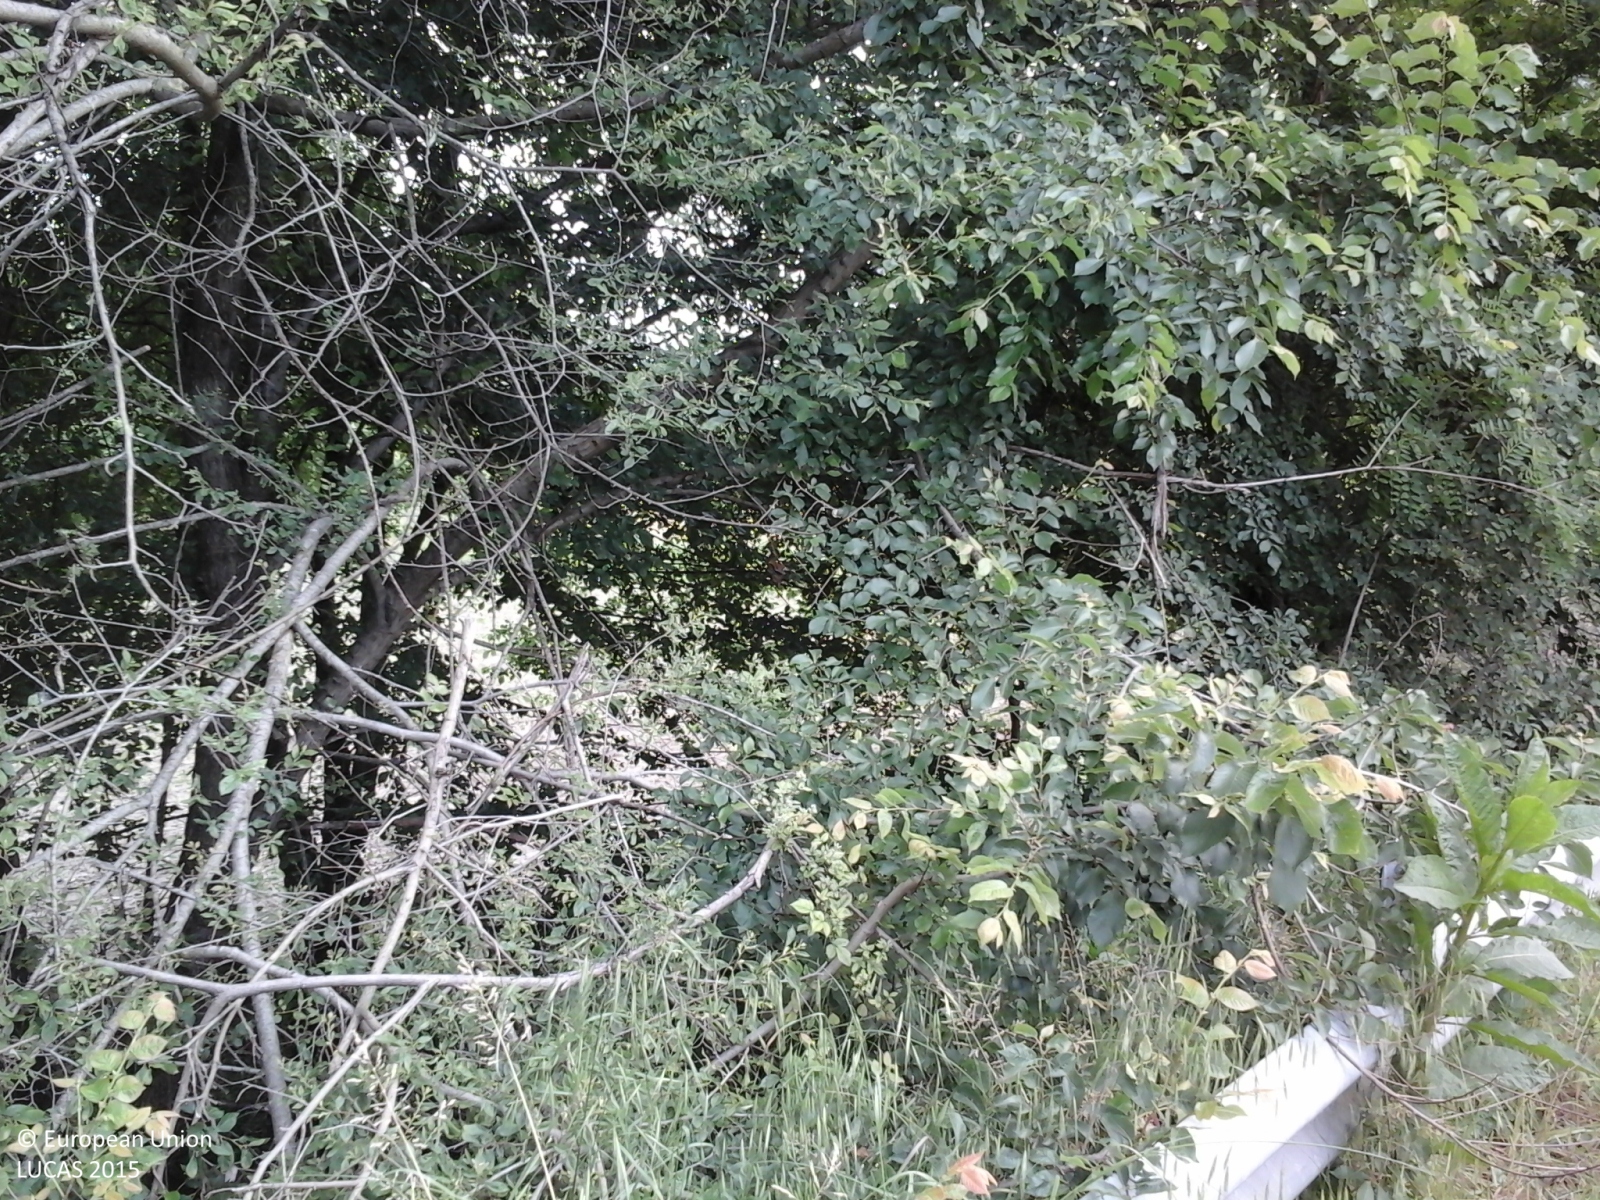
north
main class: Woodland
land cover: Broadleaved woodland
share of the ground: > 75 %
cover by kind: broadleaved forest trees 100 %
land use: Forestry
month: May
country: IT
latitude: 45.5468
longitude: 8.4271
